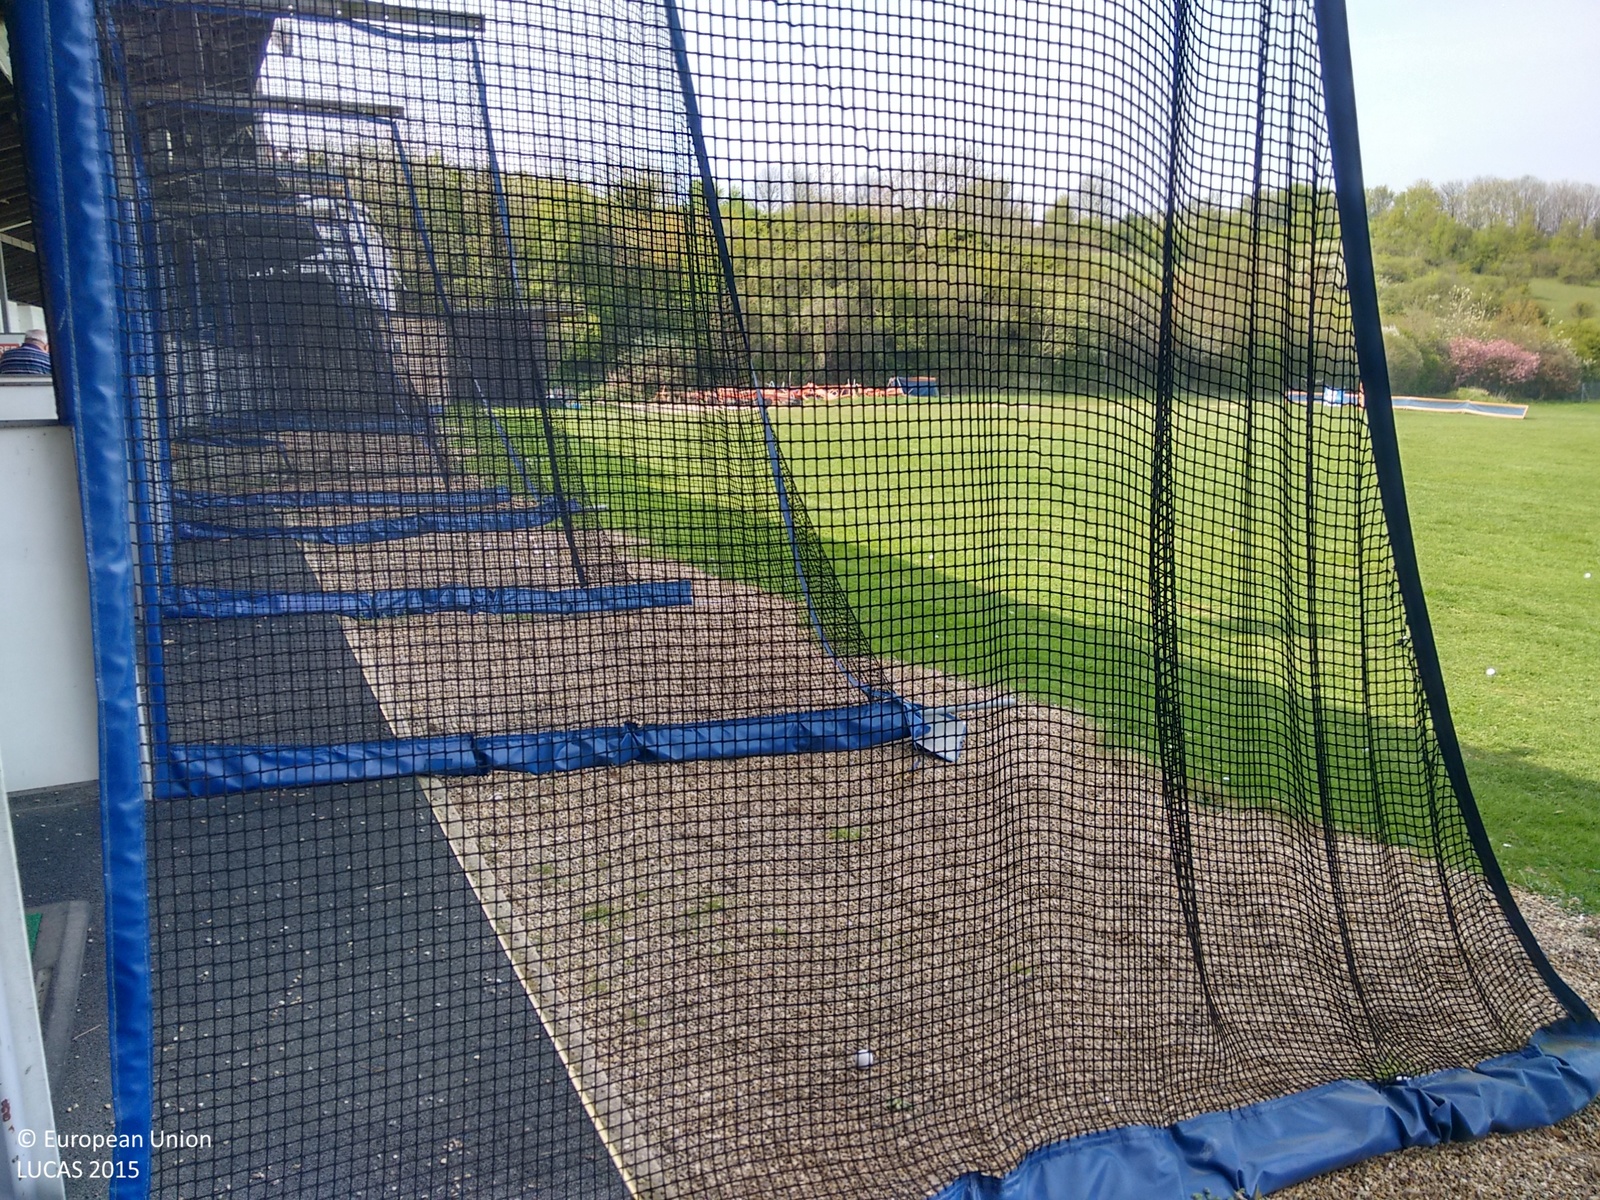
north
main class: Grassland
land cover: Grassland without tree/shrub cover
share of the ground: > 75 %
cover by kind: unconsolidated bare surface 60 %, herbaceous plants 40 %
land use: Sport
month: April
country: GB
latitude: 51.3650
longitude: 0.5360
